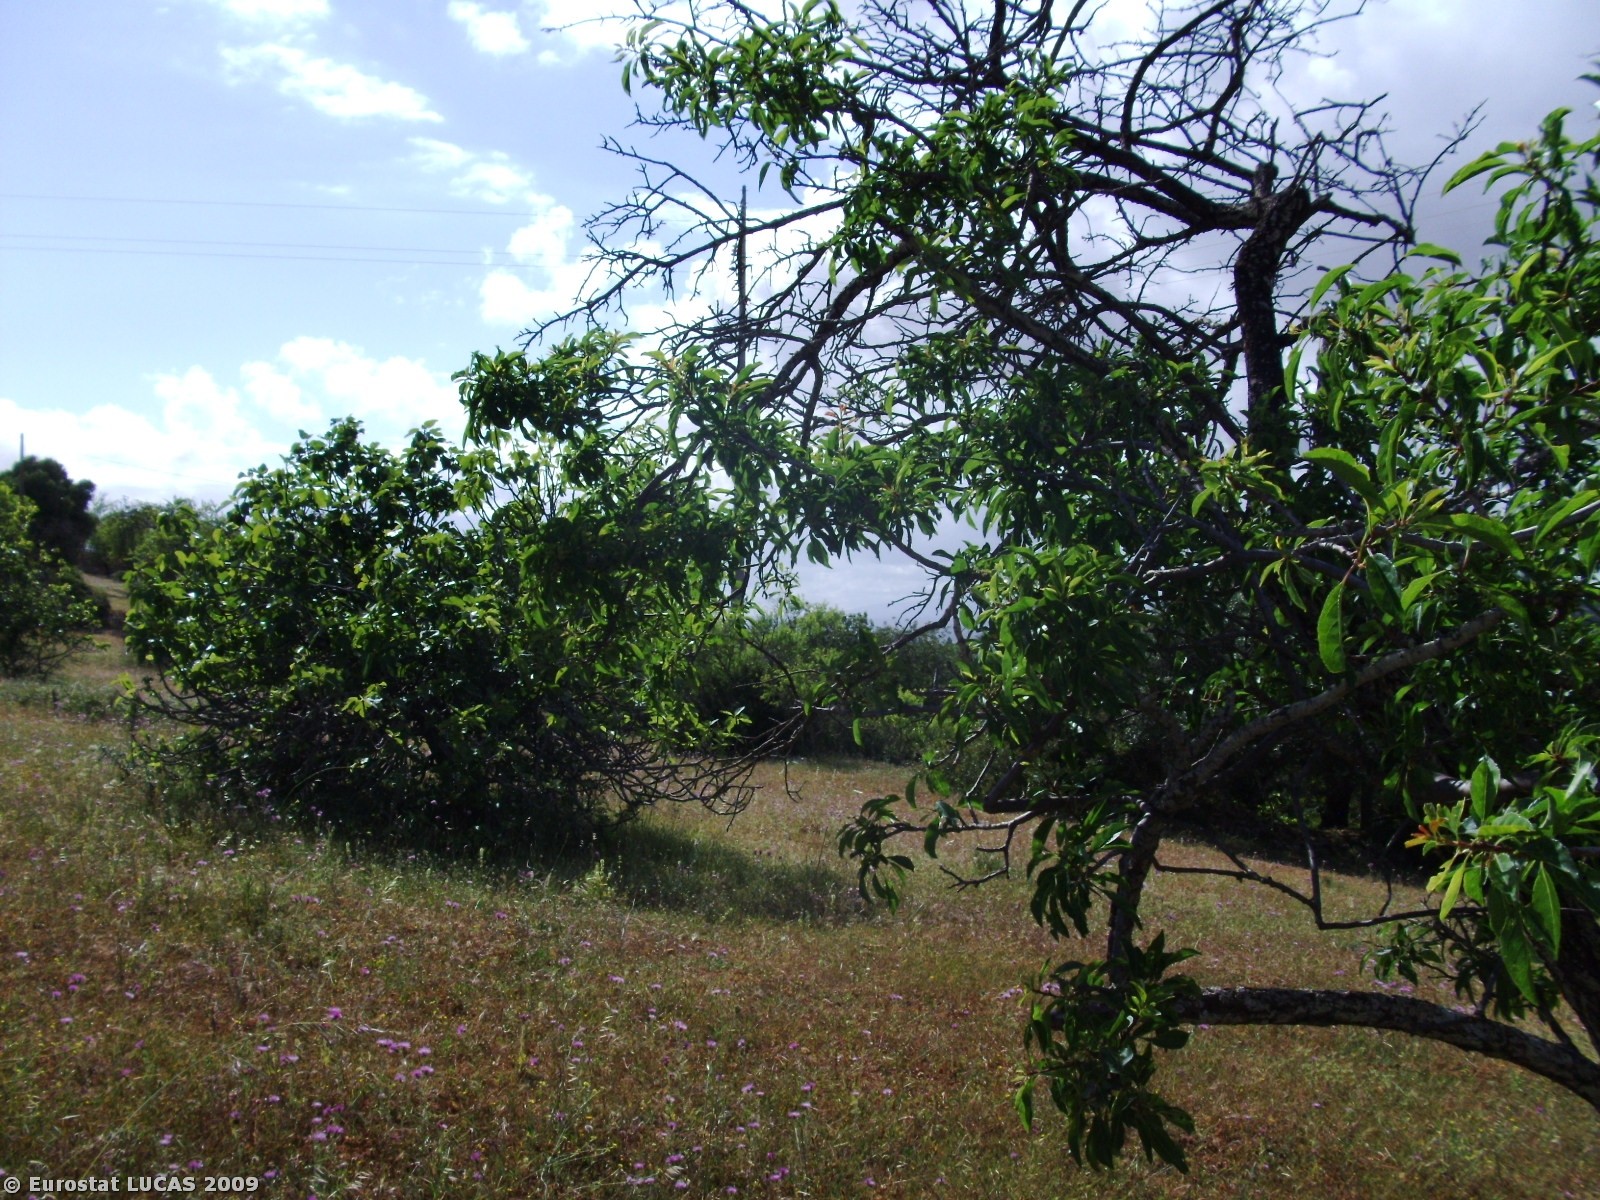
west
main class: Cropland
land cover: Nuts trees
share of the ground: 10 - 25 %
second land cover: Spontaneously vegetated surfaces
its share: 50 - 75 %
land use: Agriculture (excluding fallow land and kitchen gardens)
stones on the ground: 10 - 25 %
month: May
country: PT
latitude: 37.1557
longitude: -8.2258
